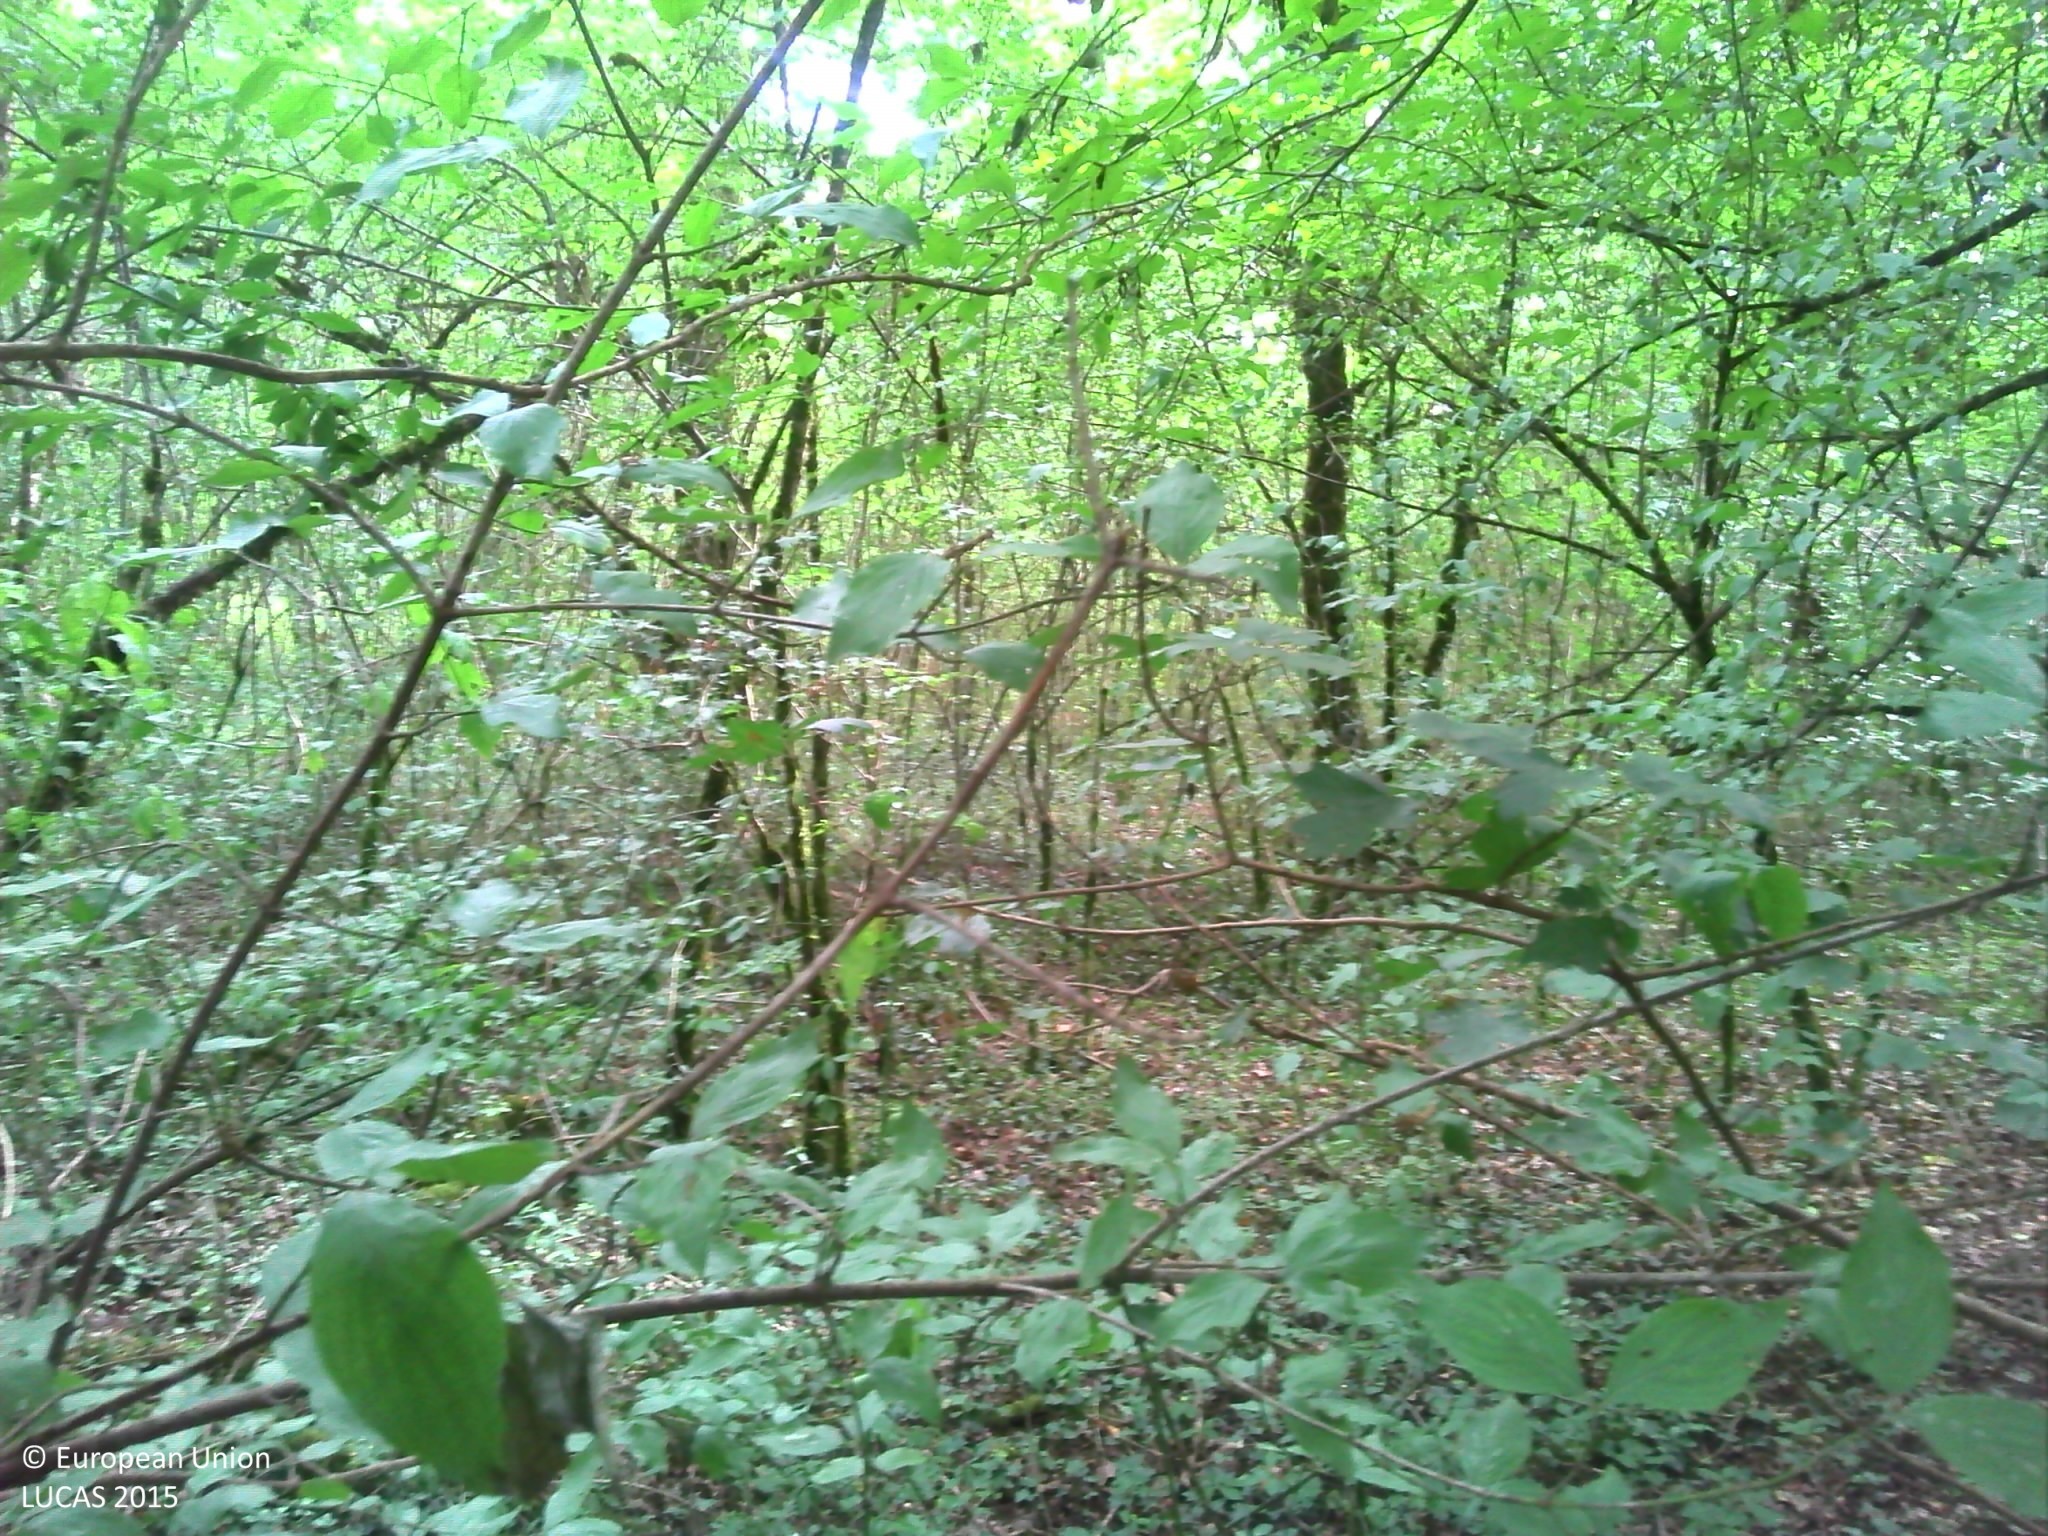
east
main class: Woodland
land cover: Broadleaved woodland
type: mesophytic deciduous forest
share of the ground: > 75 %
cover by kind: broadleaved forest trees 90 %, shrubs 5 %, herbaceous plants 5 %
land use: Forestry
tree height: > 5 m
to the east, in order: Broadleaved woodland; Ditches and canals; Paved roads, cycling and walking lanes; Sunflower; Electric lines; Sunflower
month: July
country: FR
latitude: 45.7668
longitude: 5.4393
